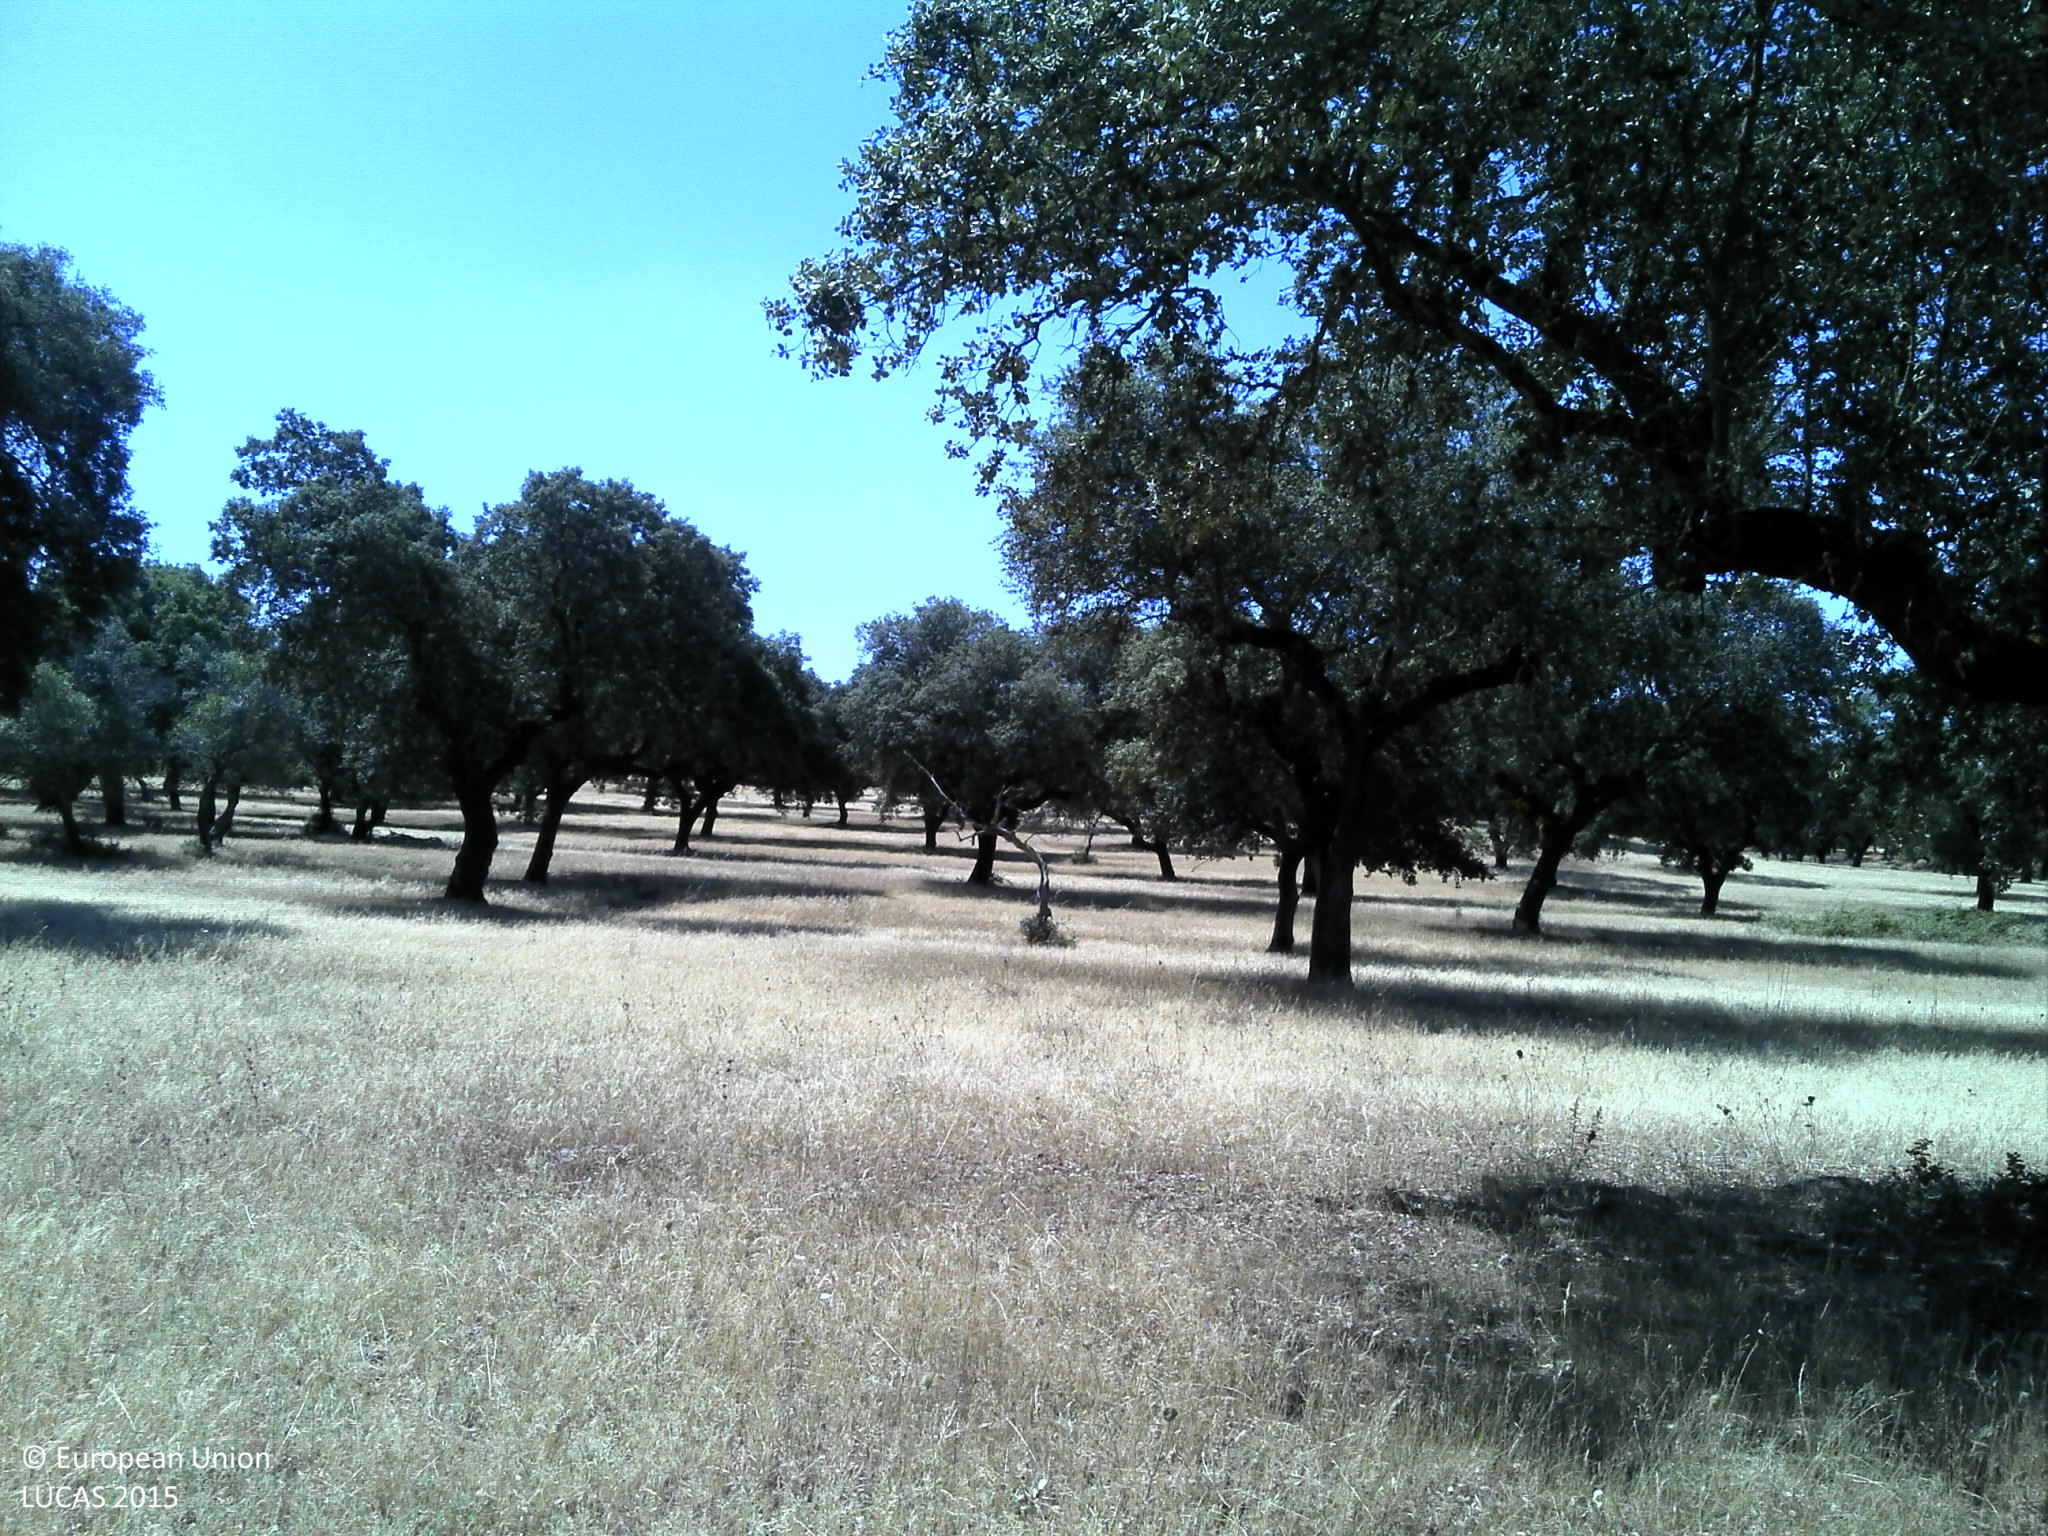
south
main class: Woodland
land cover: Broadleaved woodland
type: broadleaved evergreen forest
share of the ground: 25 - 50 %
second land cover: Grassland without tree/shrub cover
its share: 25 - 50 %
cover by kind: unconsolidated bare surface 45 %, broadleaved forest trees 30 %, herbaceous plants 25 %
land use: Forestry
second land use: Agriculture (excluding fallow land and kitchen gardens)
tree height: > 5 m
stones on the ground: < 10 %
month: June
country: PT
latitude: 38.4192
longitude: -8.1037
